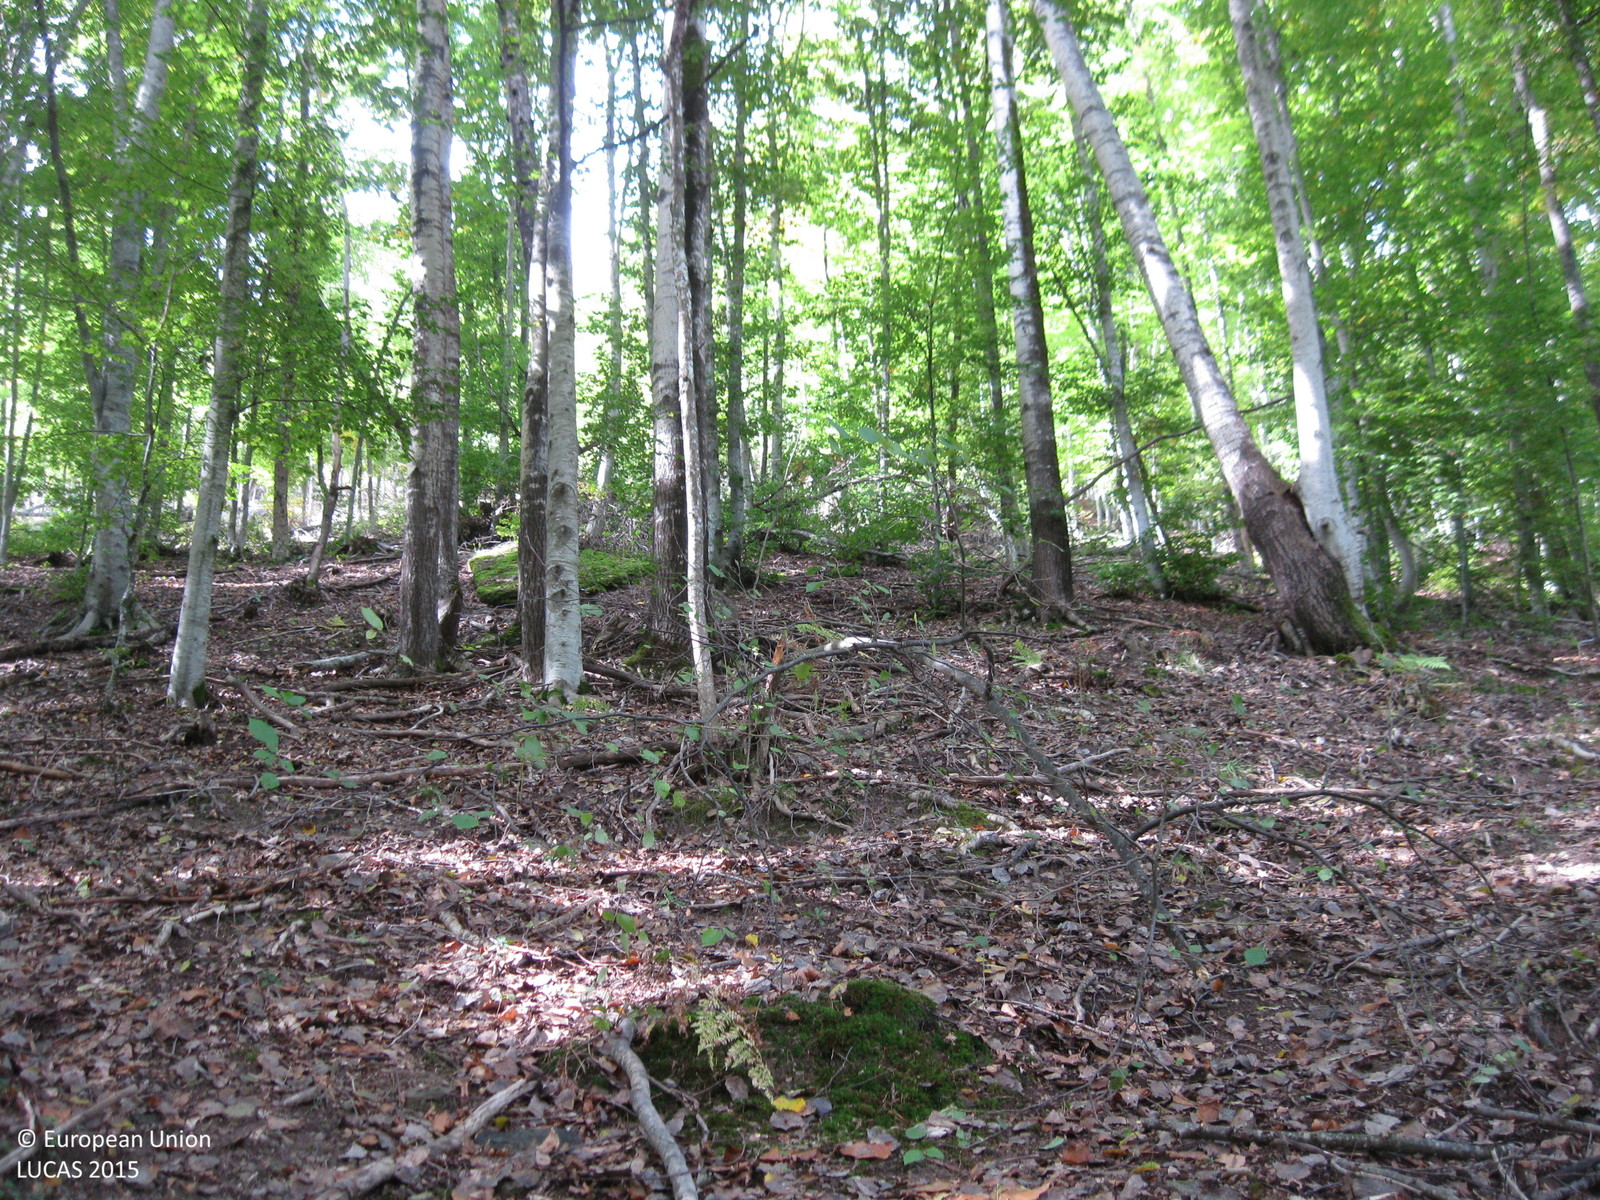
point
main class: Woodland
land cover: Broadleaved woodland
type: mountainous beech forest
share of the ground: > 75 %
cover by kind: broadleaved forest trees 90 %, shrubs 5 %, lichens and mosses 5 %
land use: Forestry
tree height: > 5 m
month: October
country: BG
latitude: 41.7782
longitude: 24.9328
